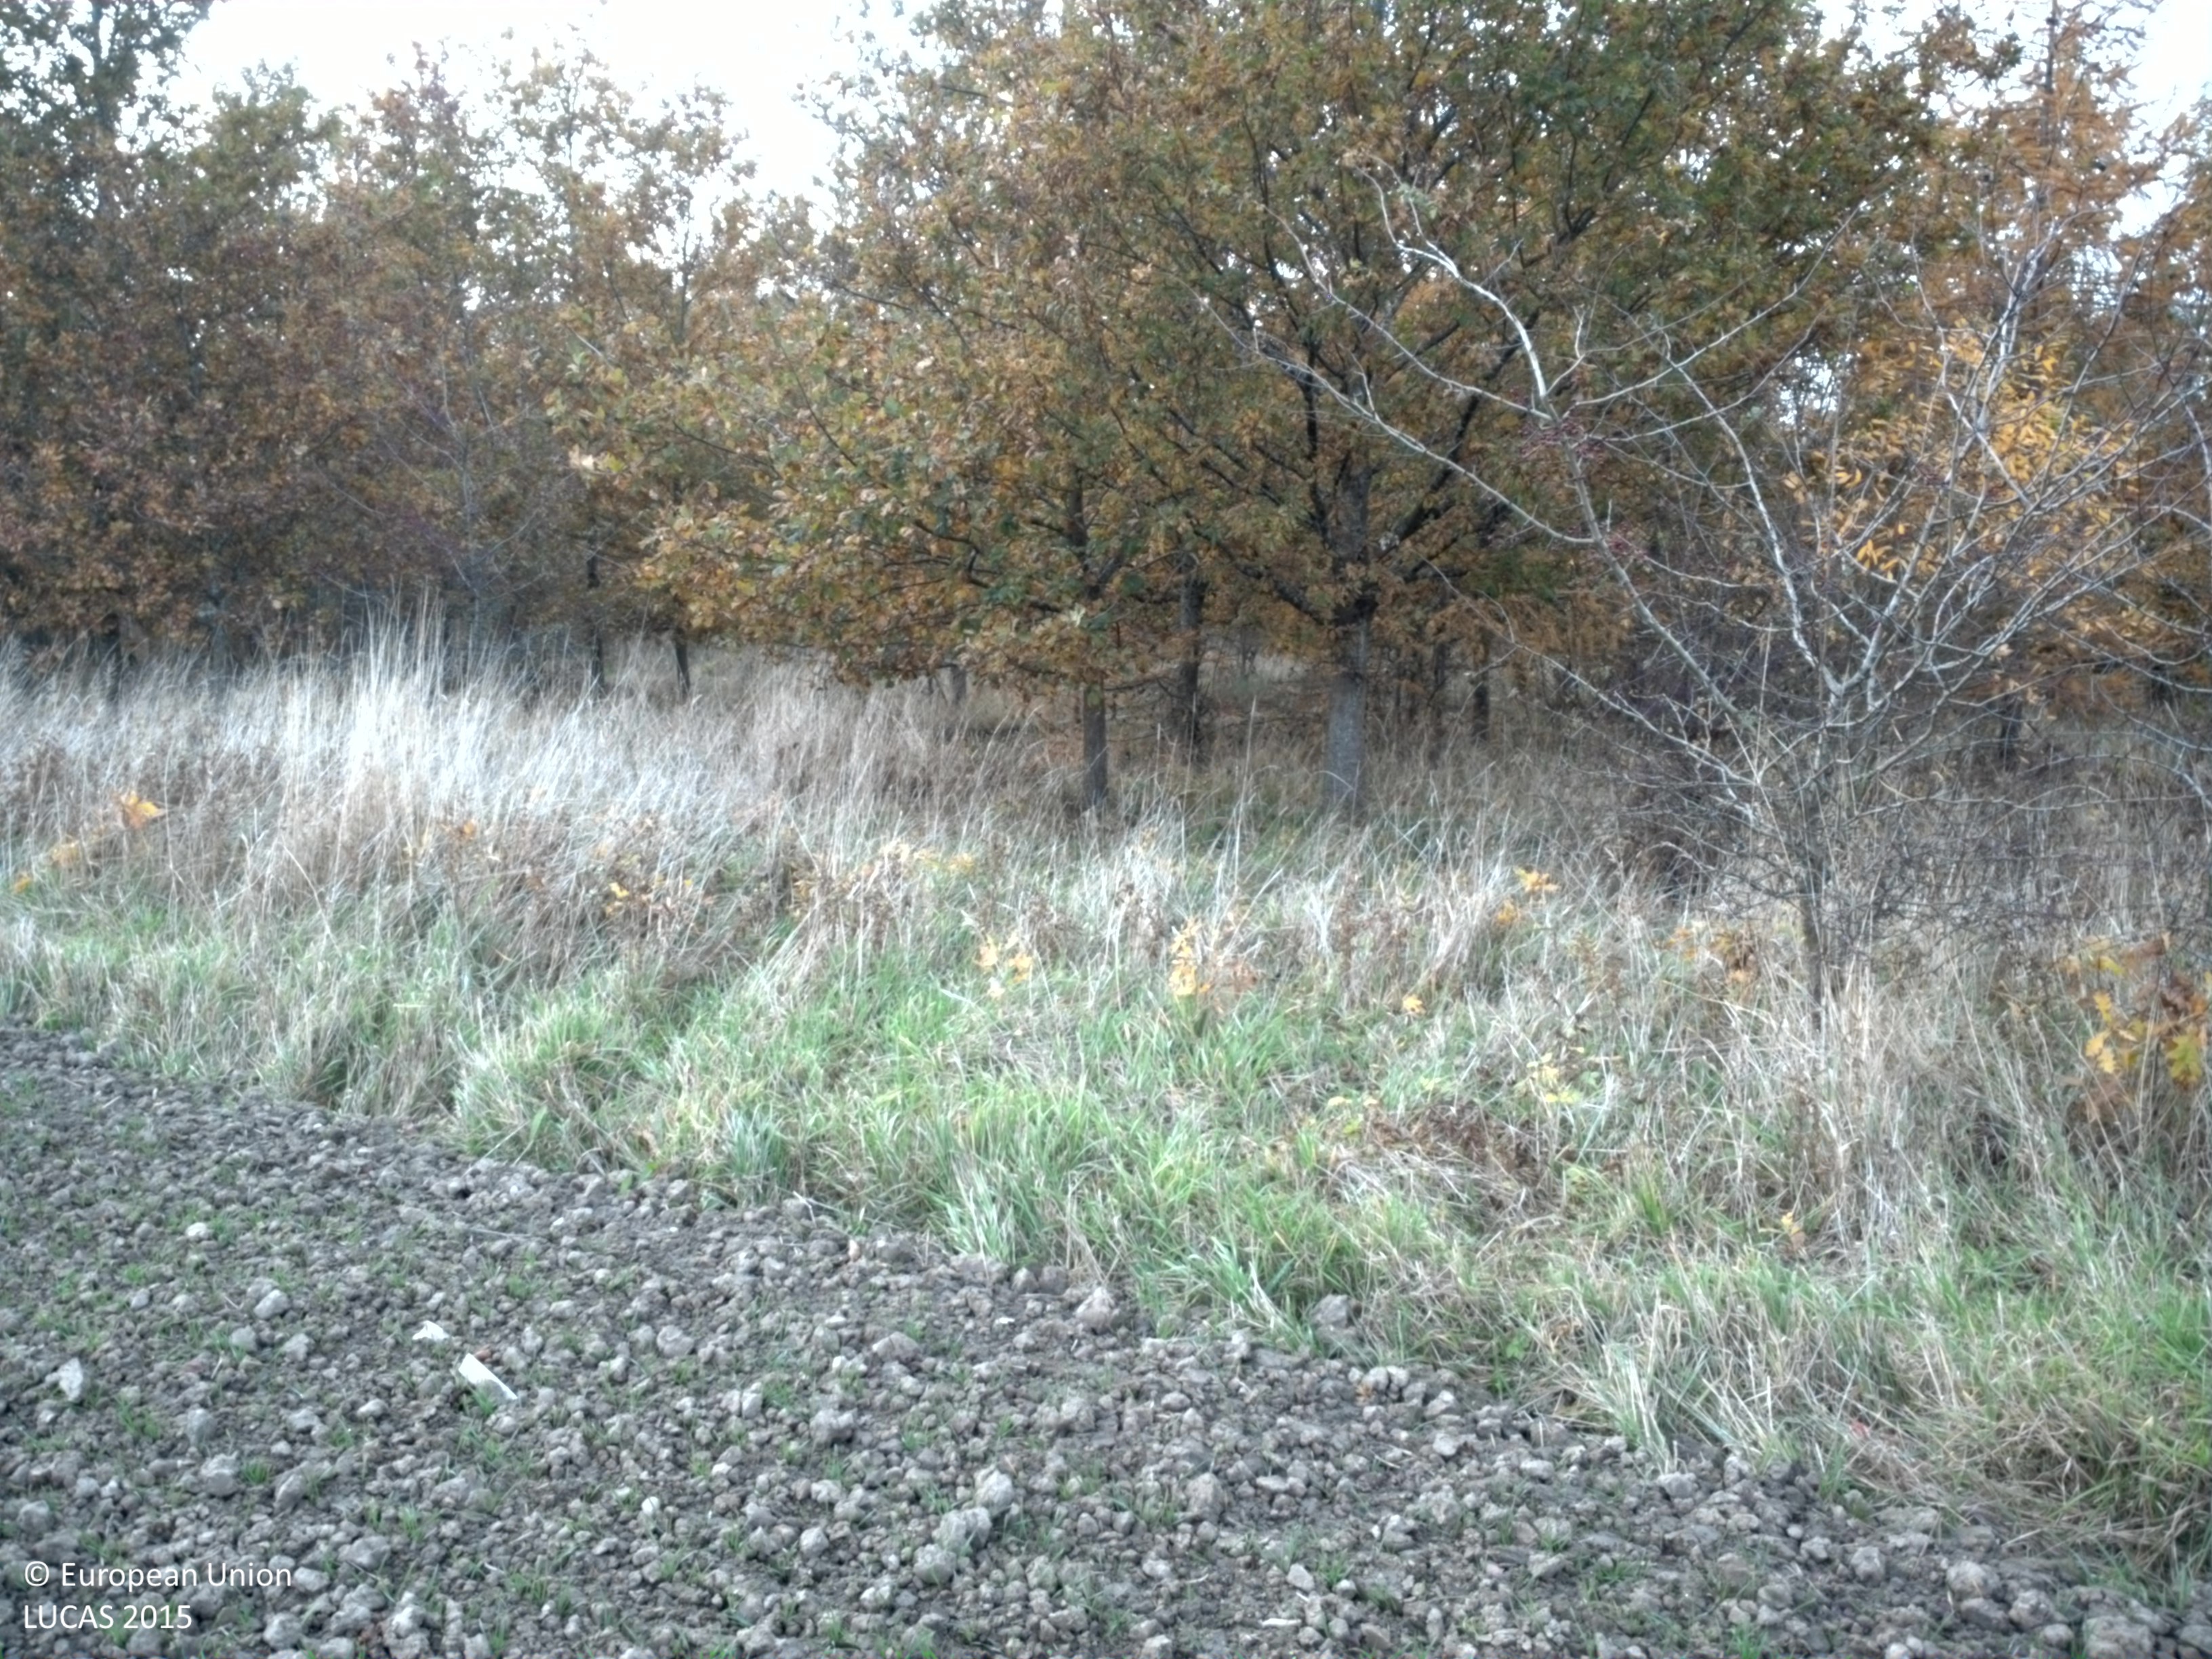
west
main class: Cropland
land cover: Common wheat
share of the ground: < 10 %
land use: Agriculture (excluding fallow land and kitchen gardens)
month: November
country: SE
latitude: 56.1323
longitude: 13.1028
